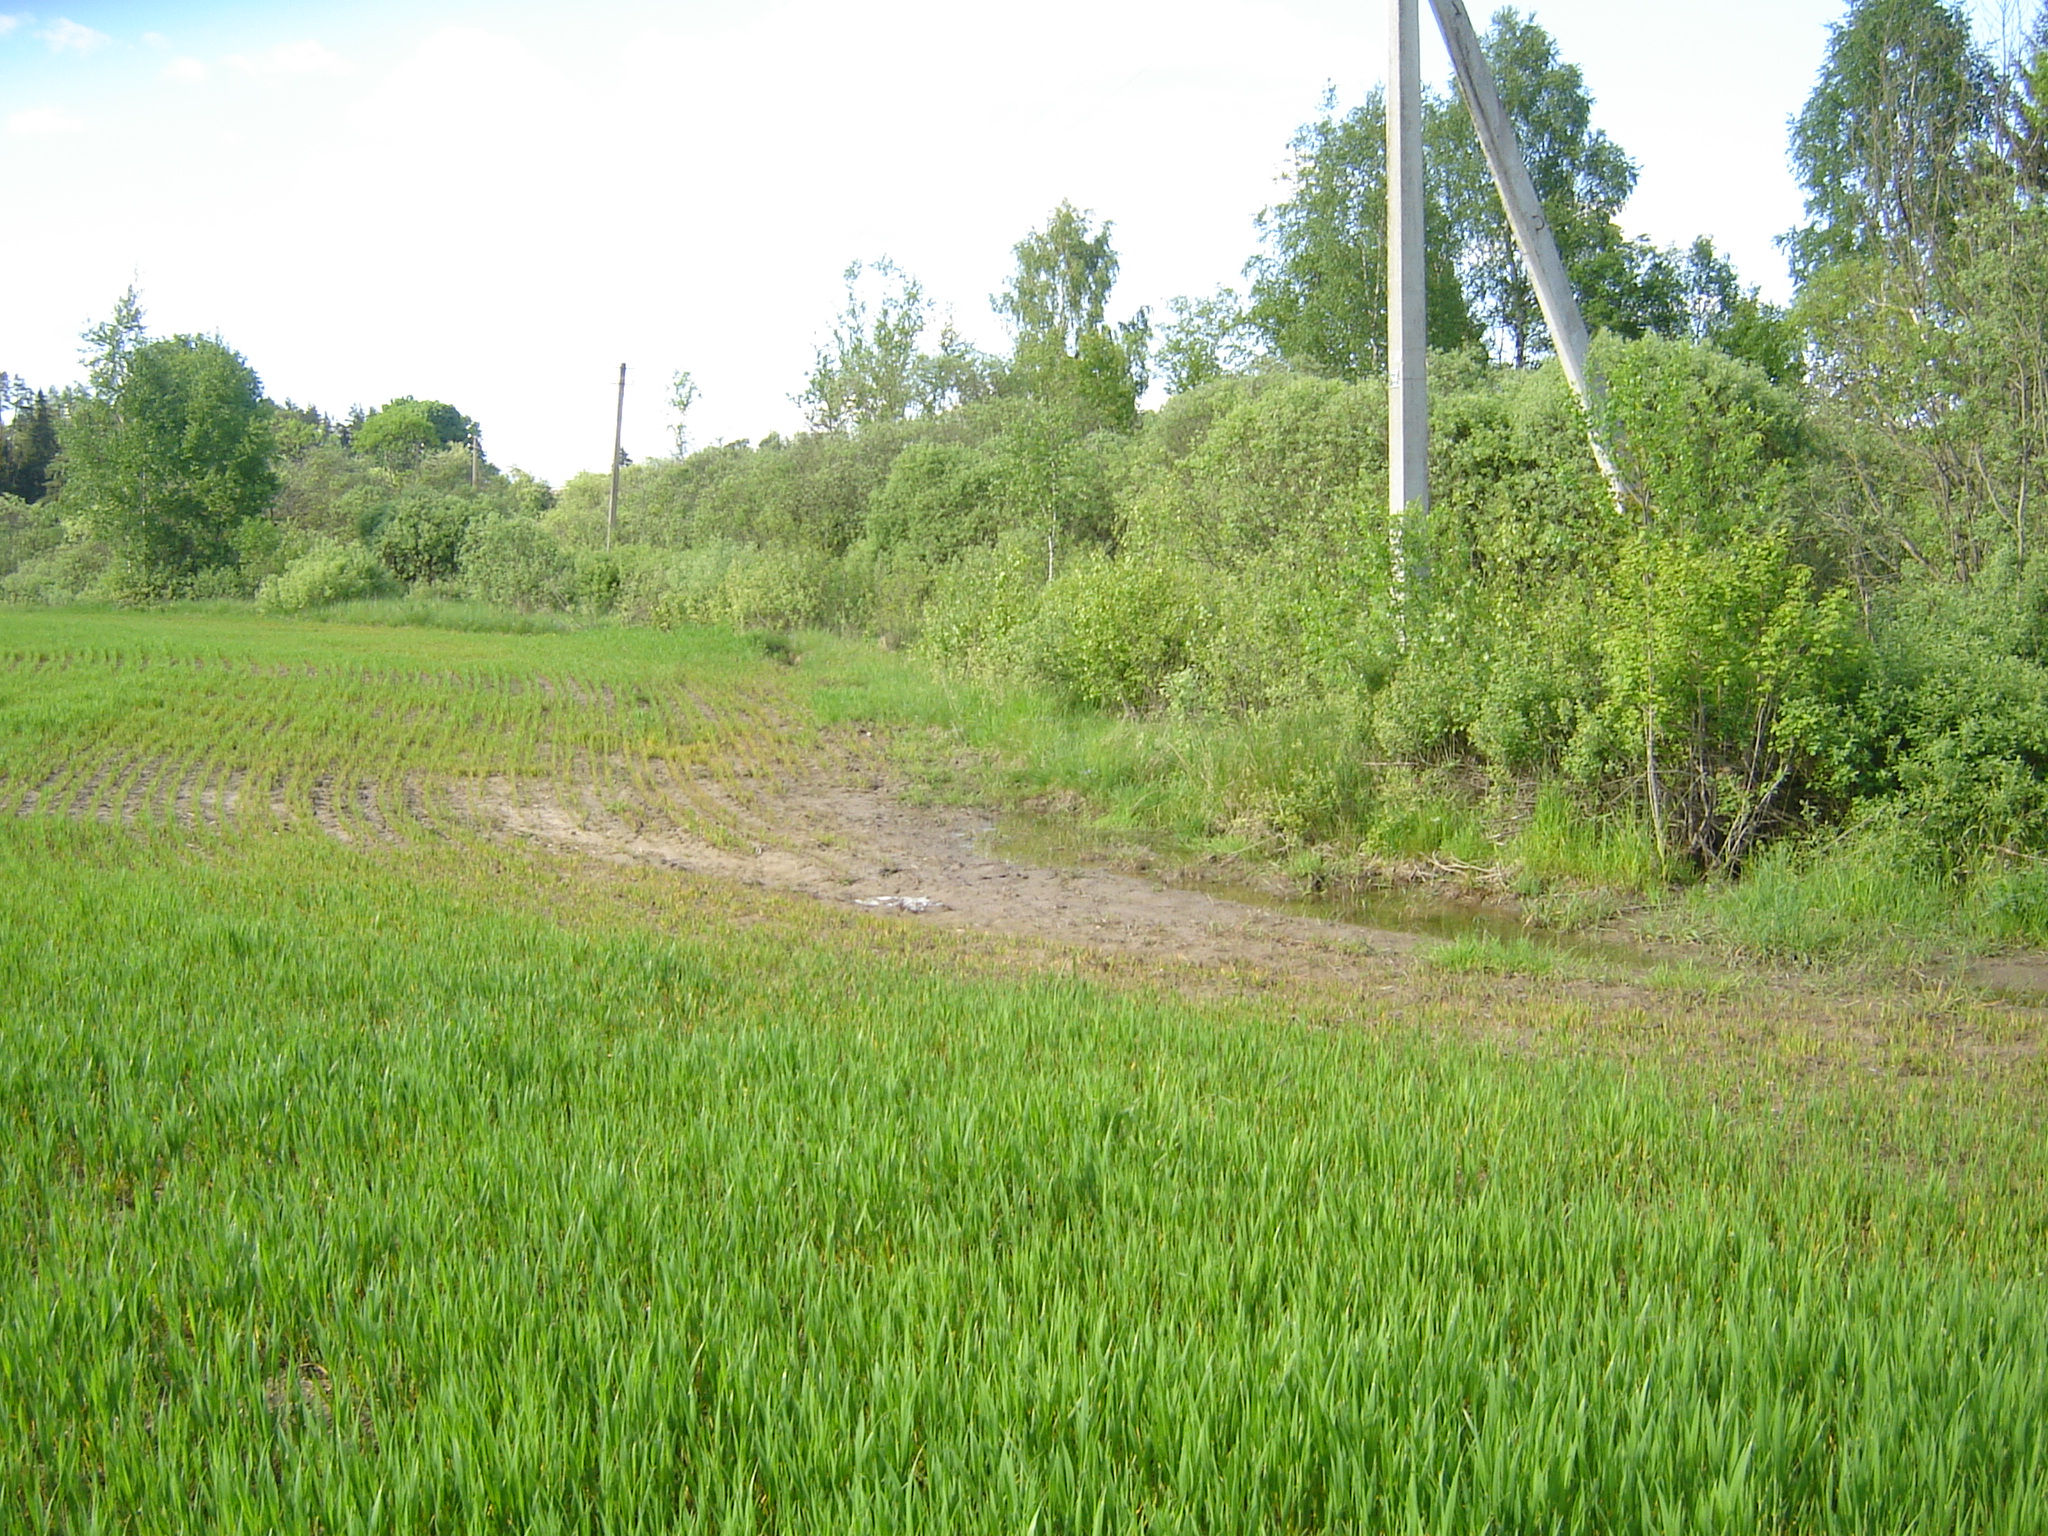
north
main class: Cropland
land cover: Barley
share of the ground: > 75 %
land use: Agriculture (excluding fallow land and kitchen gardens)
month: May
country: LT
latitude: 55.7295
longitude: 25.2280
